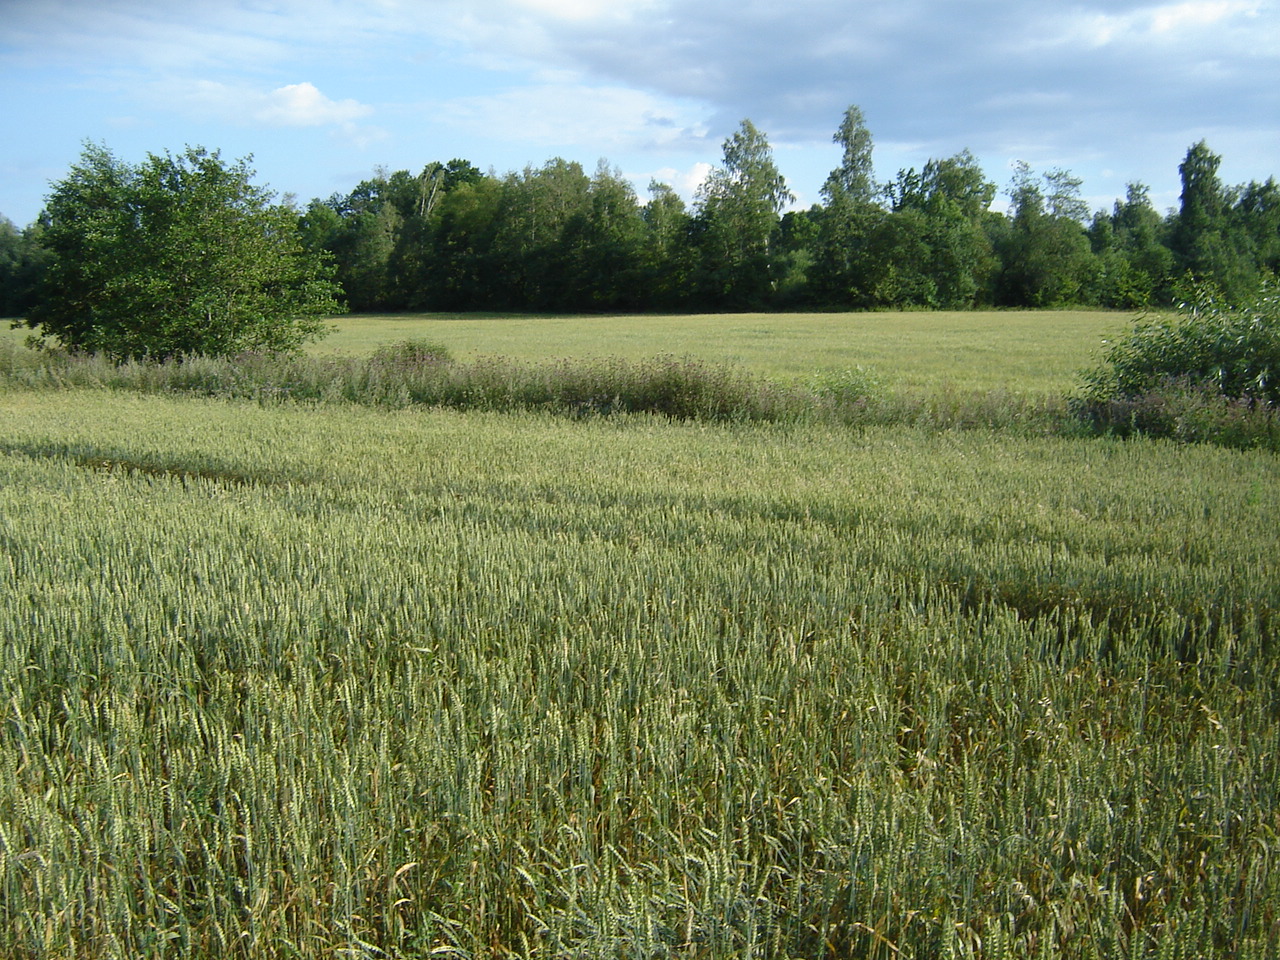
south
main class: Cropland
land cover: Common wheat
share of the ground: > 75 %
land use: Agriculture (excluding fallow land and kitchen gardens)
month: July
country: LT
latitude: 55.3323
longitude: 24.7186
